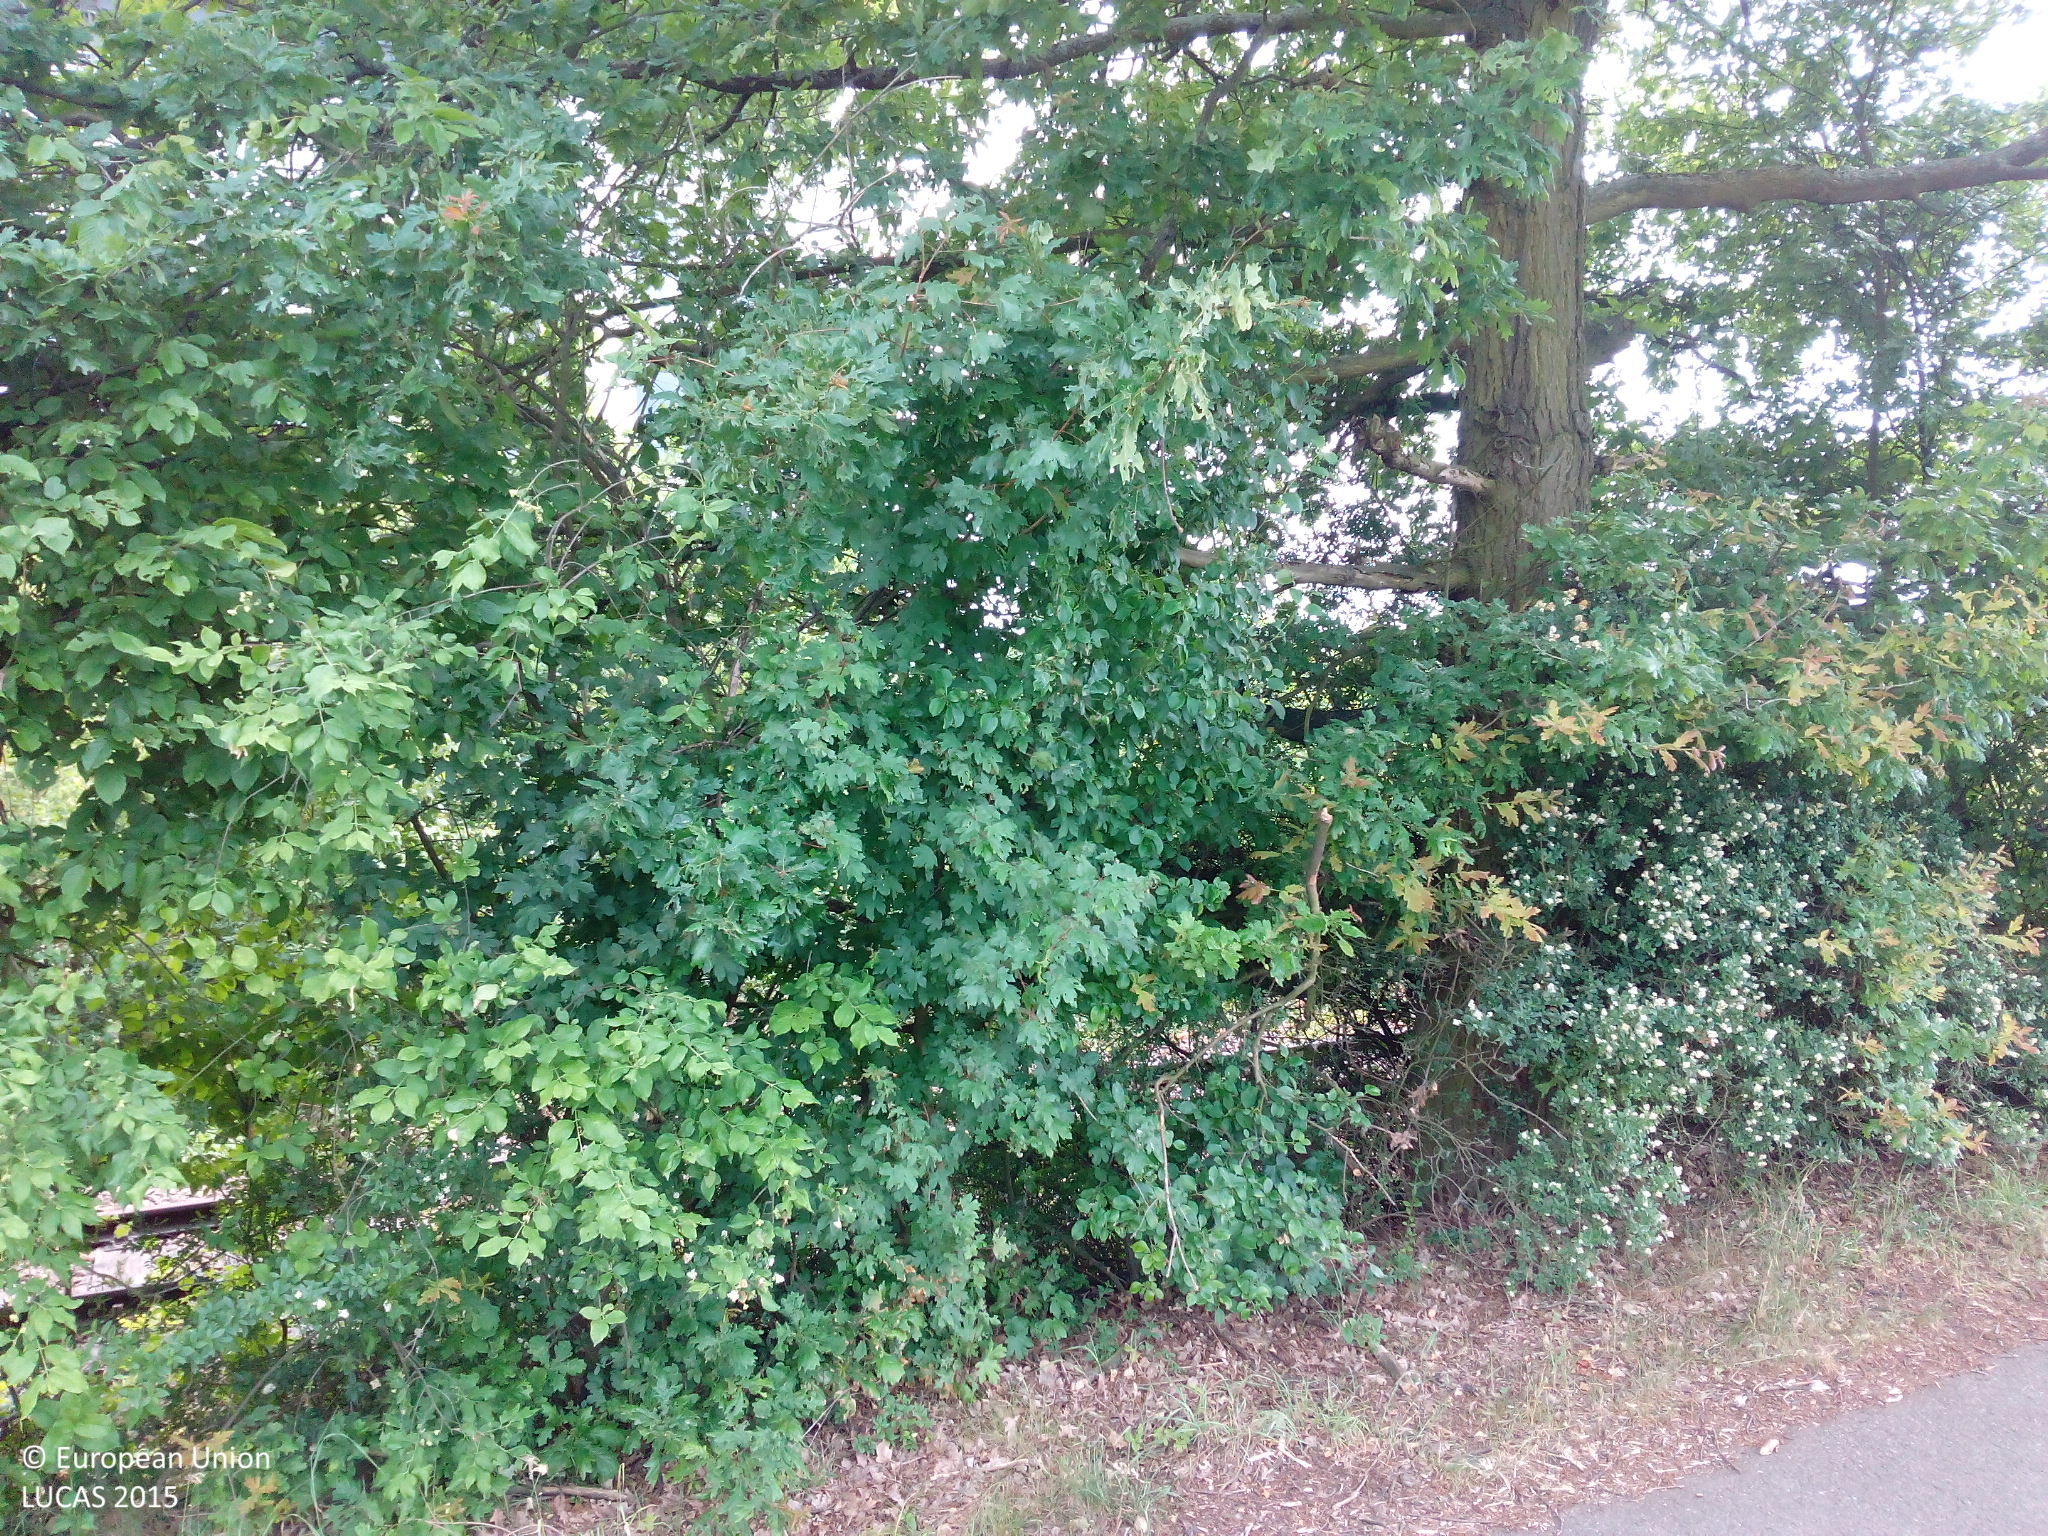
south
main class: Cropland
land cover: Rye
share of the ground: > 75 %
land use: Agriculture (excluding fallow land and kitchen gardens)
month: June
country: DE
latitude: 49.2162
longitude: 8.1747
